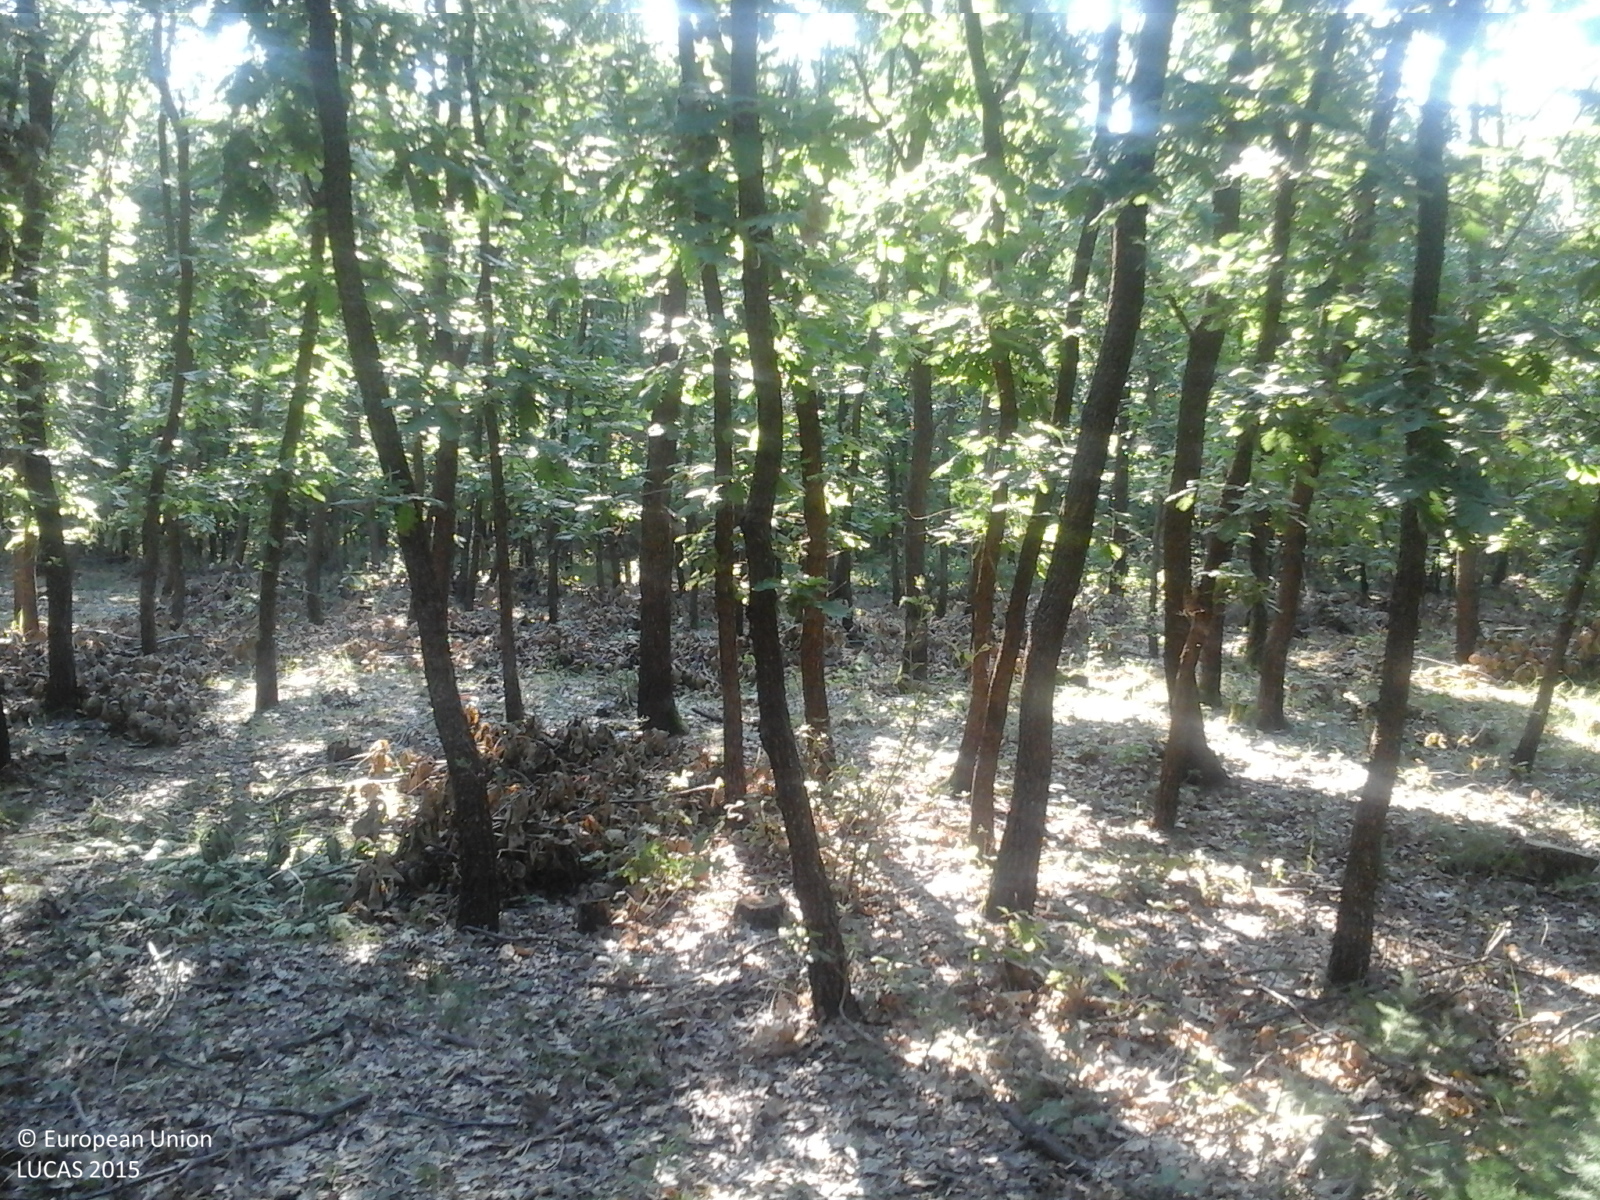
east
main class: Woodland
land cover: Broadleaved woodland
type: acidophilous oak and oak-birch forest
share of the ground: > 75 %
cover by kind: broadleaved forest trees 100 %
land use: Forestry
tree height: > 5 m
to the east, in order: Broadleaved woodland
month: July
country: RO
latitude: 44.5258
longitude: 24.8116
